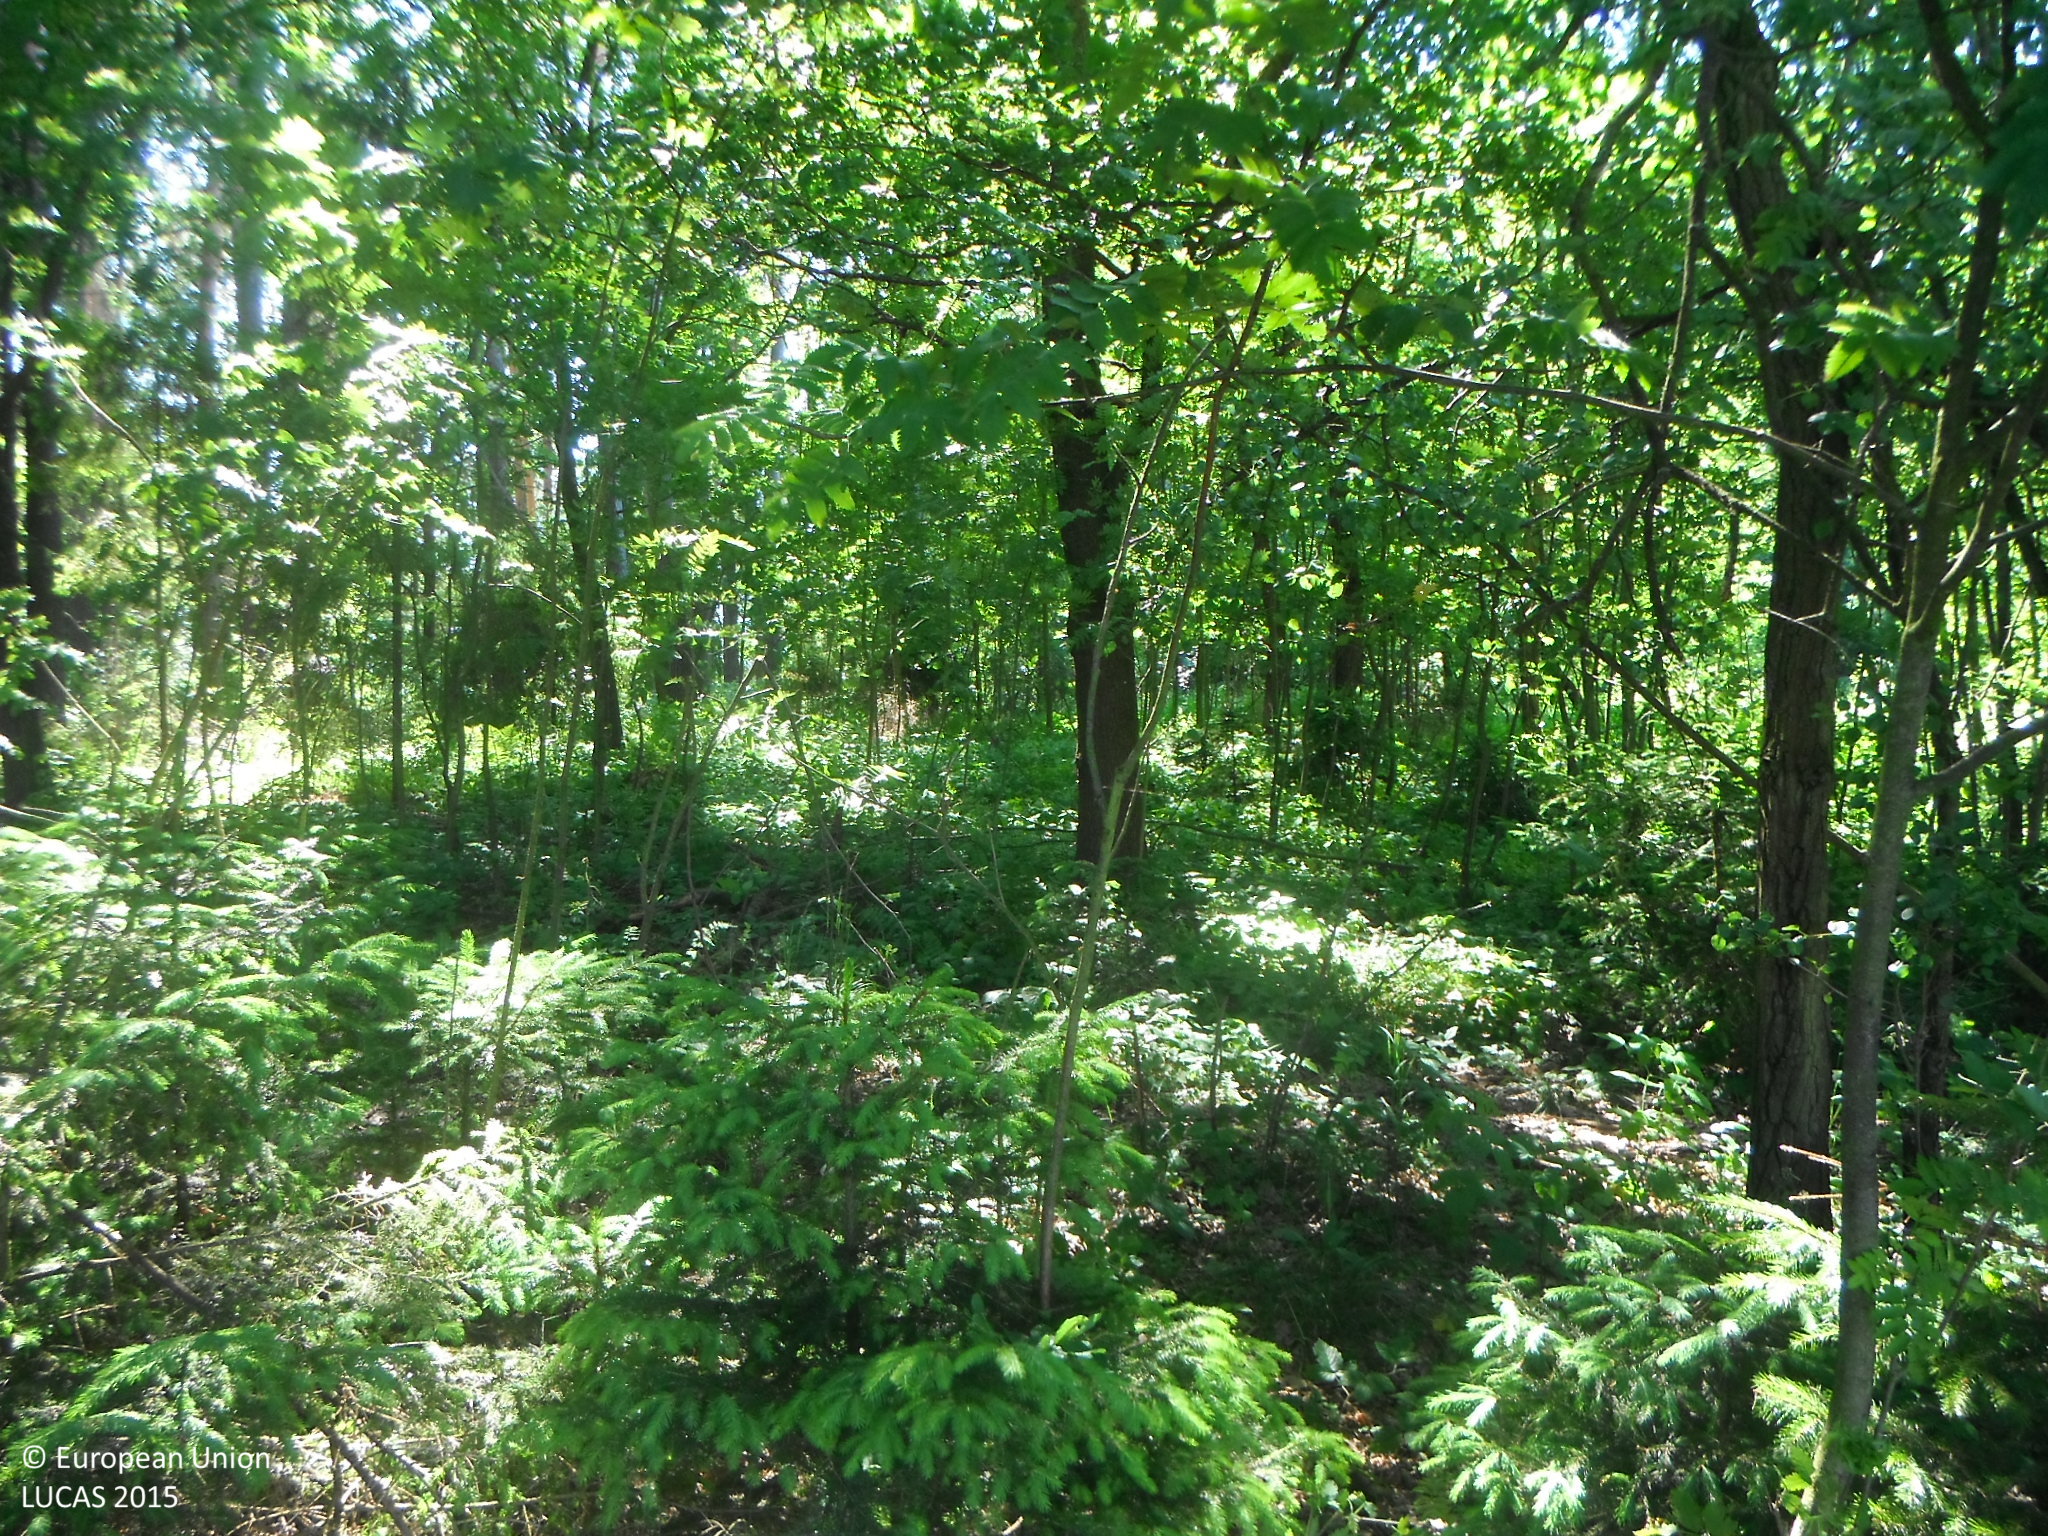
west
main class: Woodland
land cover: Other mixed woodland
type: hemiboreal forest and nemoral coniferous forest and mixed broadleaved-coniferous forest
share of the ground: > 75 %
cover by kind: broadleaved forest trees 55 %, coniferous forest trees 40 %, herbaceous plants 5 %
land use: Forestry
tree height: > 5 m
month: July
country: SK
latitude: 48.9353
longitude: 20.6997
